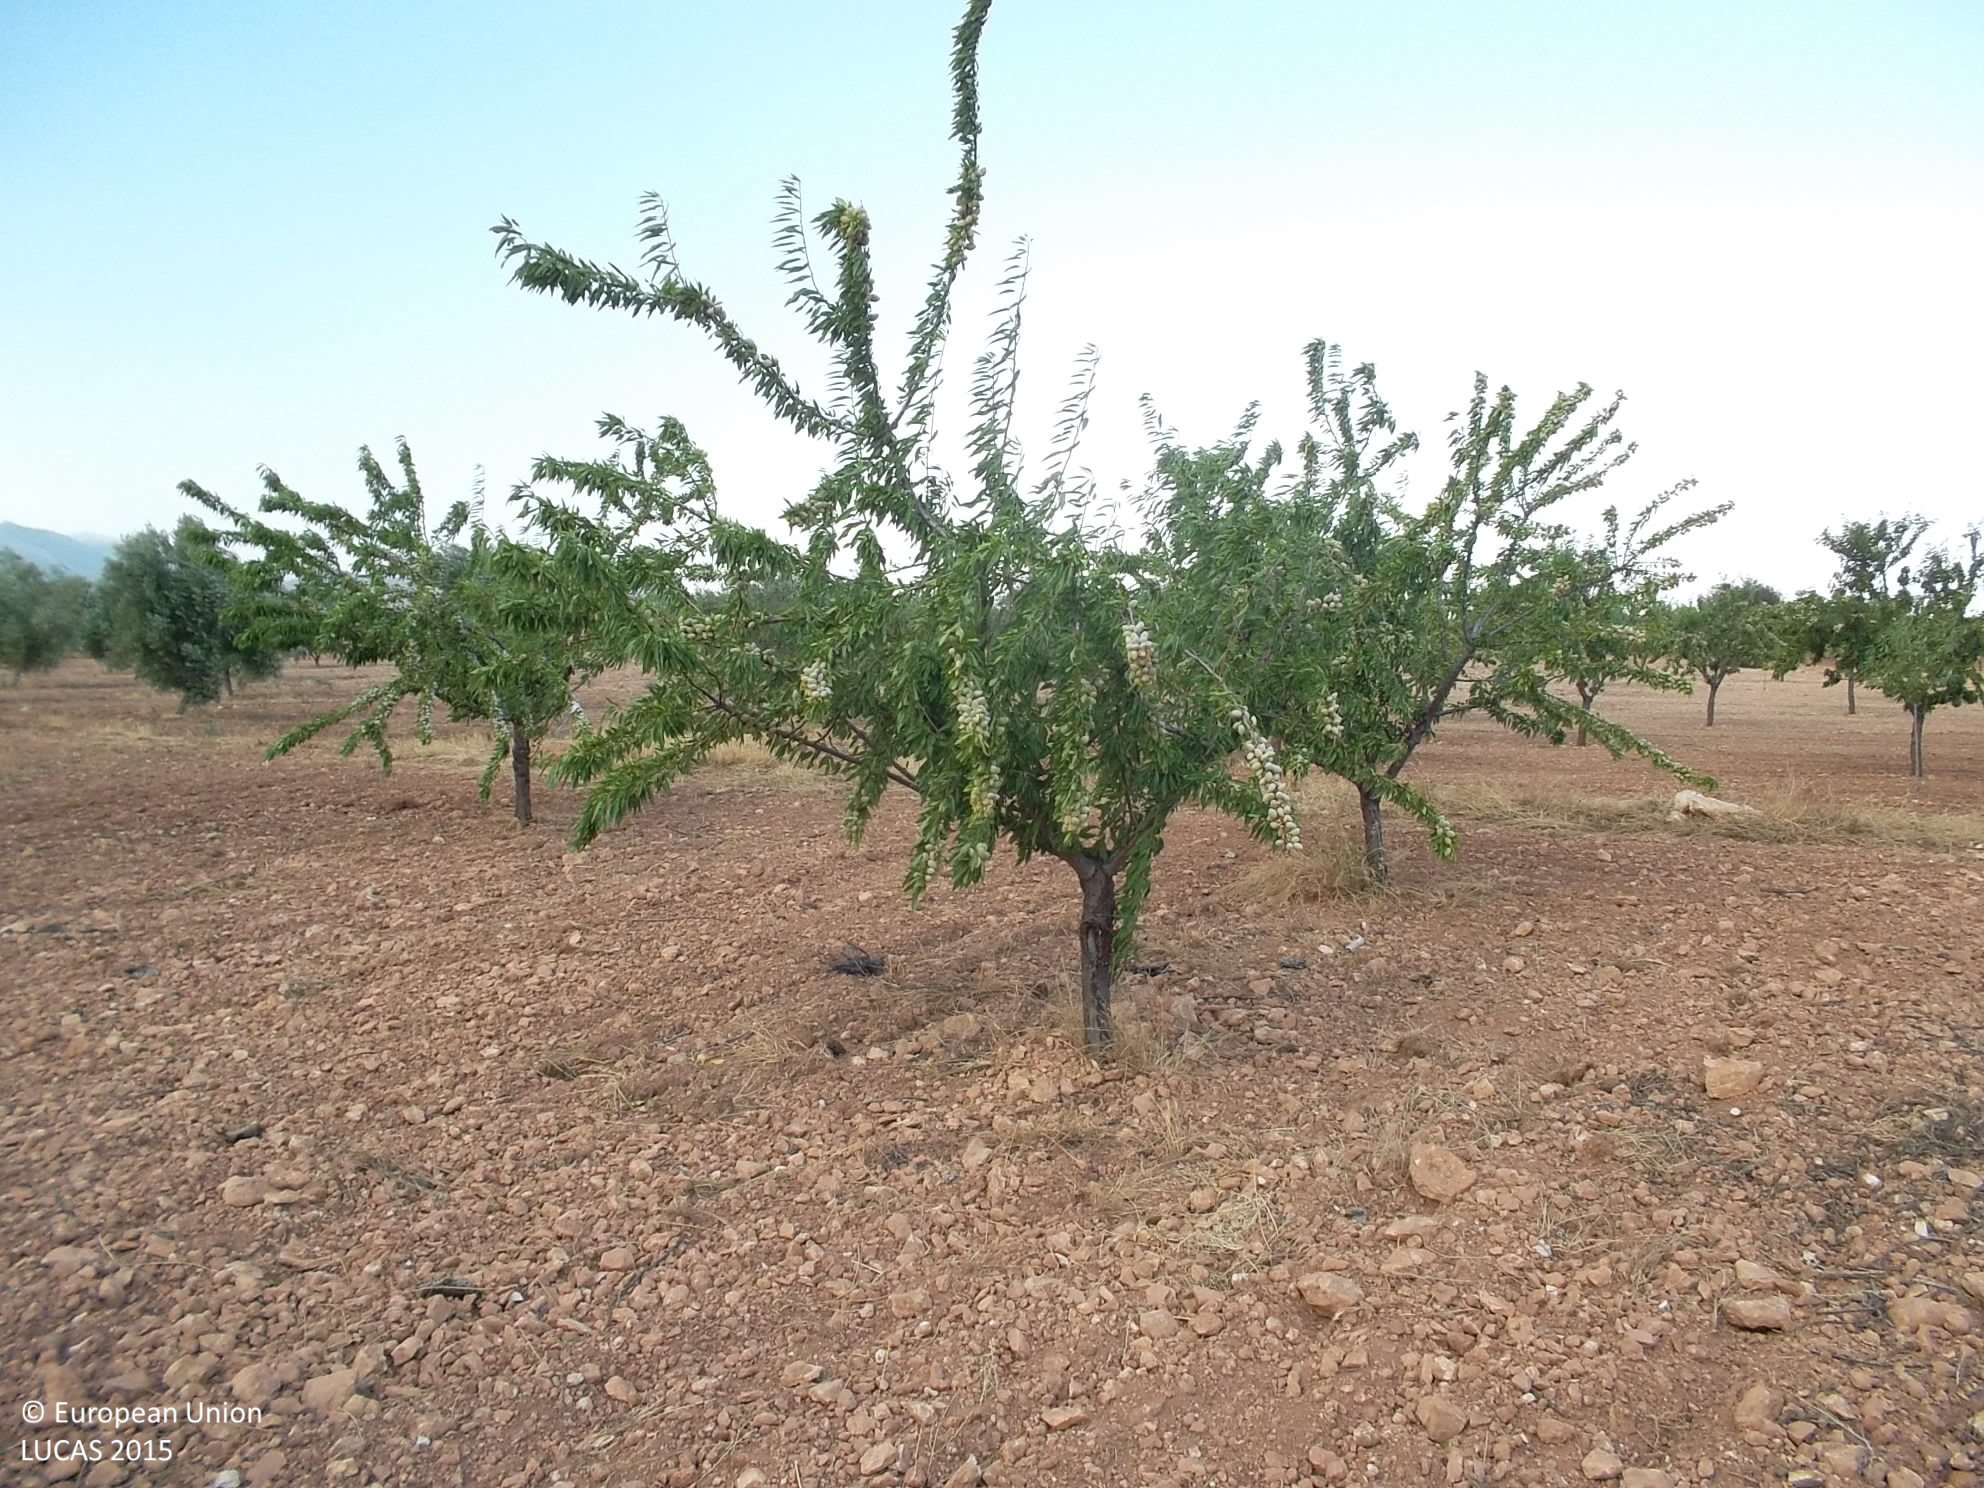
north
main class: Cropland
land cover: Nuts trees
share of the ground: 25 - 50 %
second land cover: Other bare soil
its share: > 75 %
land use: Agriculture (excluding fallow land and kitchen gardens)
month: July
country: ES
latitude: 37.7252
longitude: -2.7771
